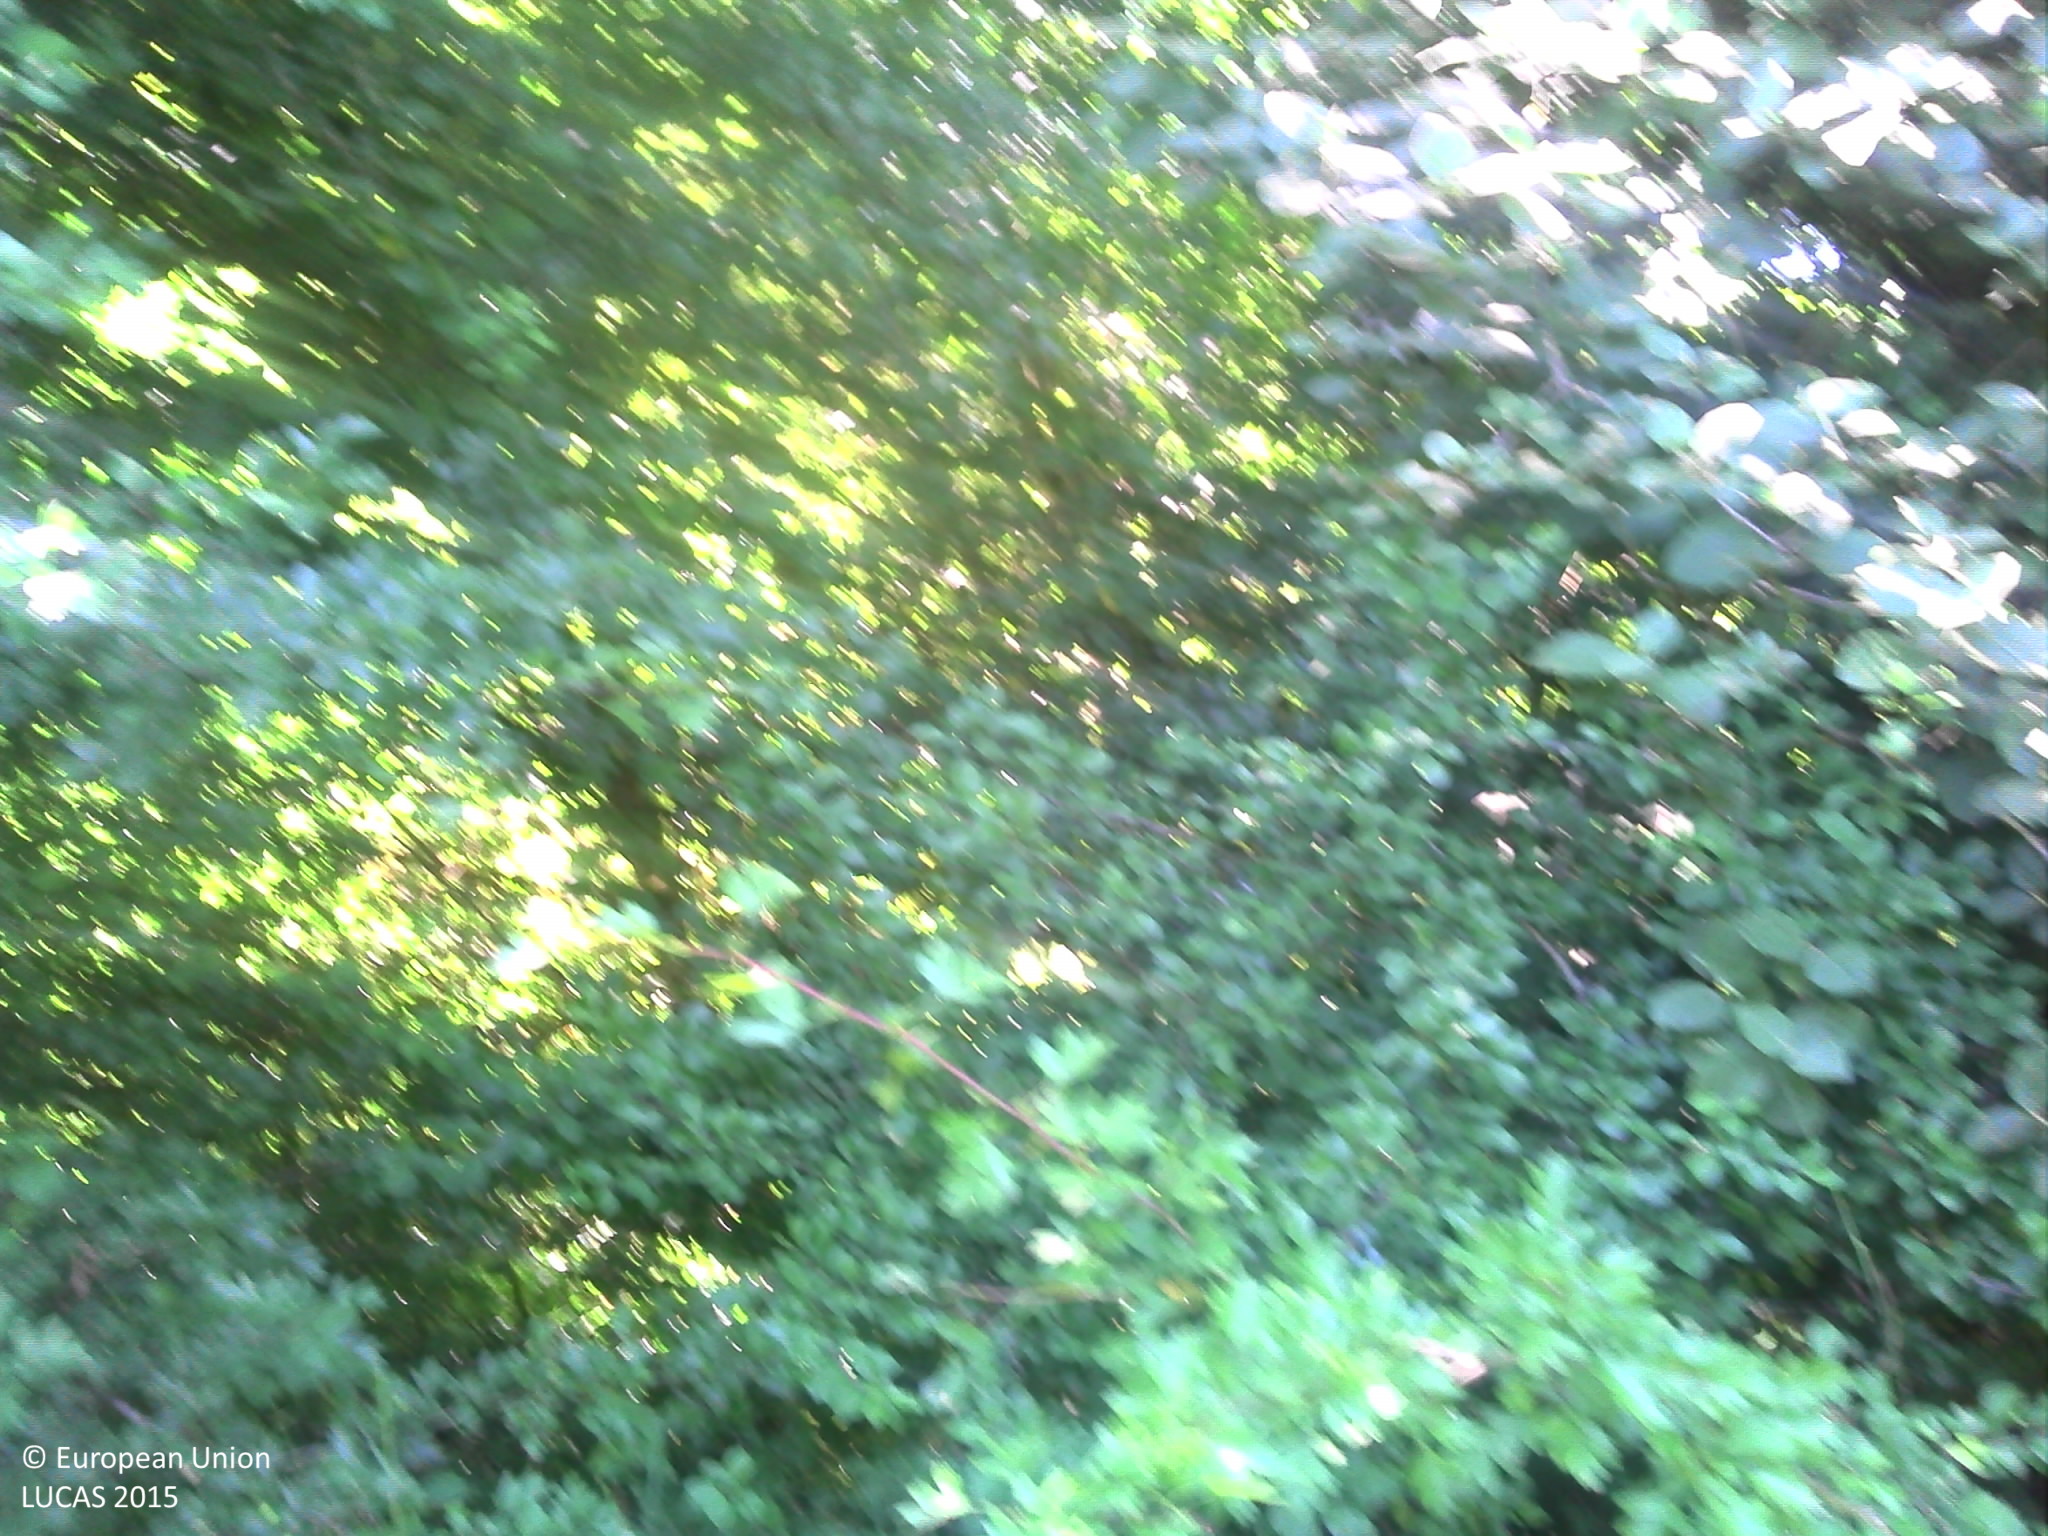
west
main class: Woodland
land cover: Broadleaved woodland
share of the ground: 10 - 25 %
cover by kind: herbaceous plants 70 %, broadleaved forest trees 20 %, shrubs 10 %
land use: Forestry
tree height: < 5 m
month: July
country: FR
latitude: 48.1261
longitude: 5.3644
